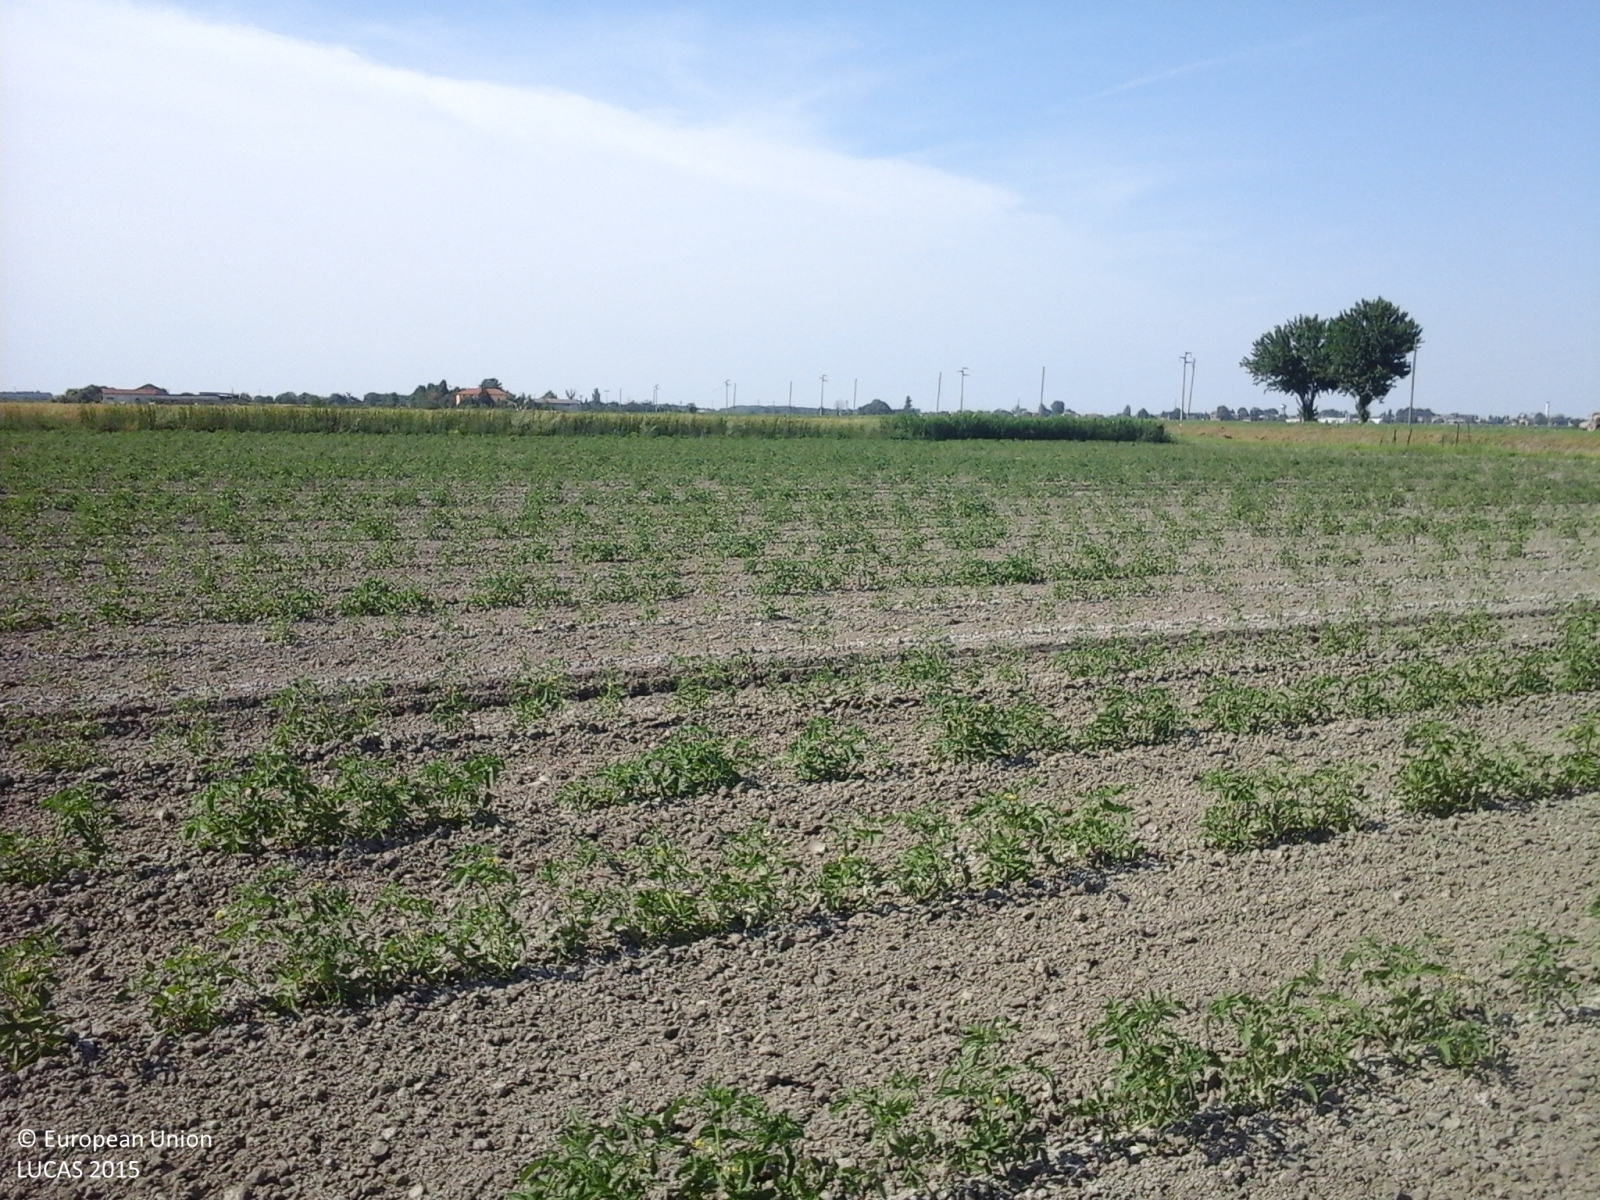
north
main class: Cropland
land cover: Tomatoes
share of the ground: 10 - 25 %
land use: Agriculture (excluding fallow land and kitchen gardens)
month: June
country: IT
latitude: 44.6223
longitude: 11.8740
